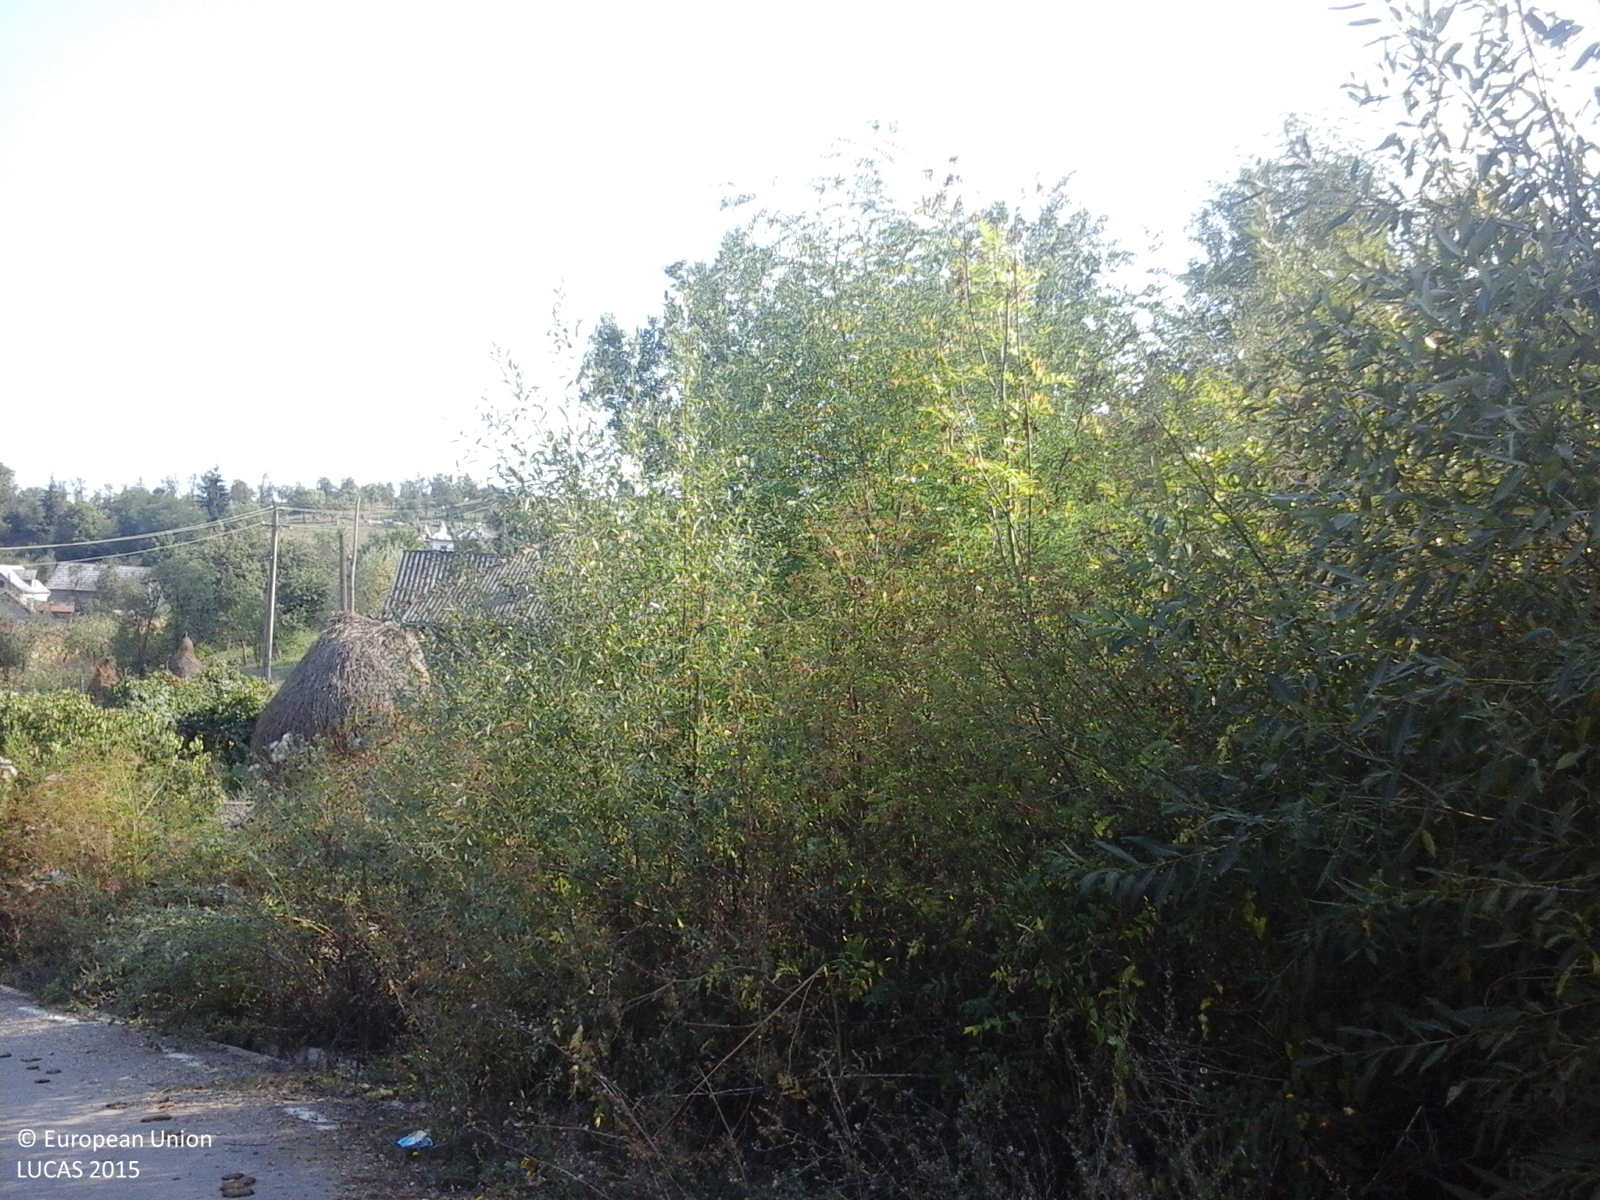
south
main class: Shrubland
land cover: Shrubland with sparse tree cover
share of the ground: > 75 %
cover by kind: shrubs 95 %, broadleaved forest trees 5 %
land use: Semi-natural and natural areas not in use
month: September
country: RO
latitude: 47.0981
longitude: 24.1953
